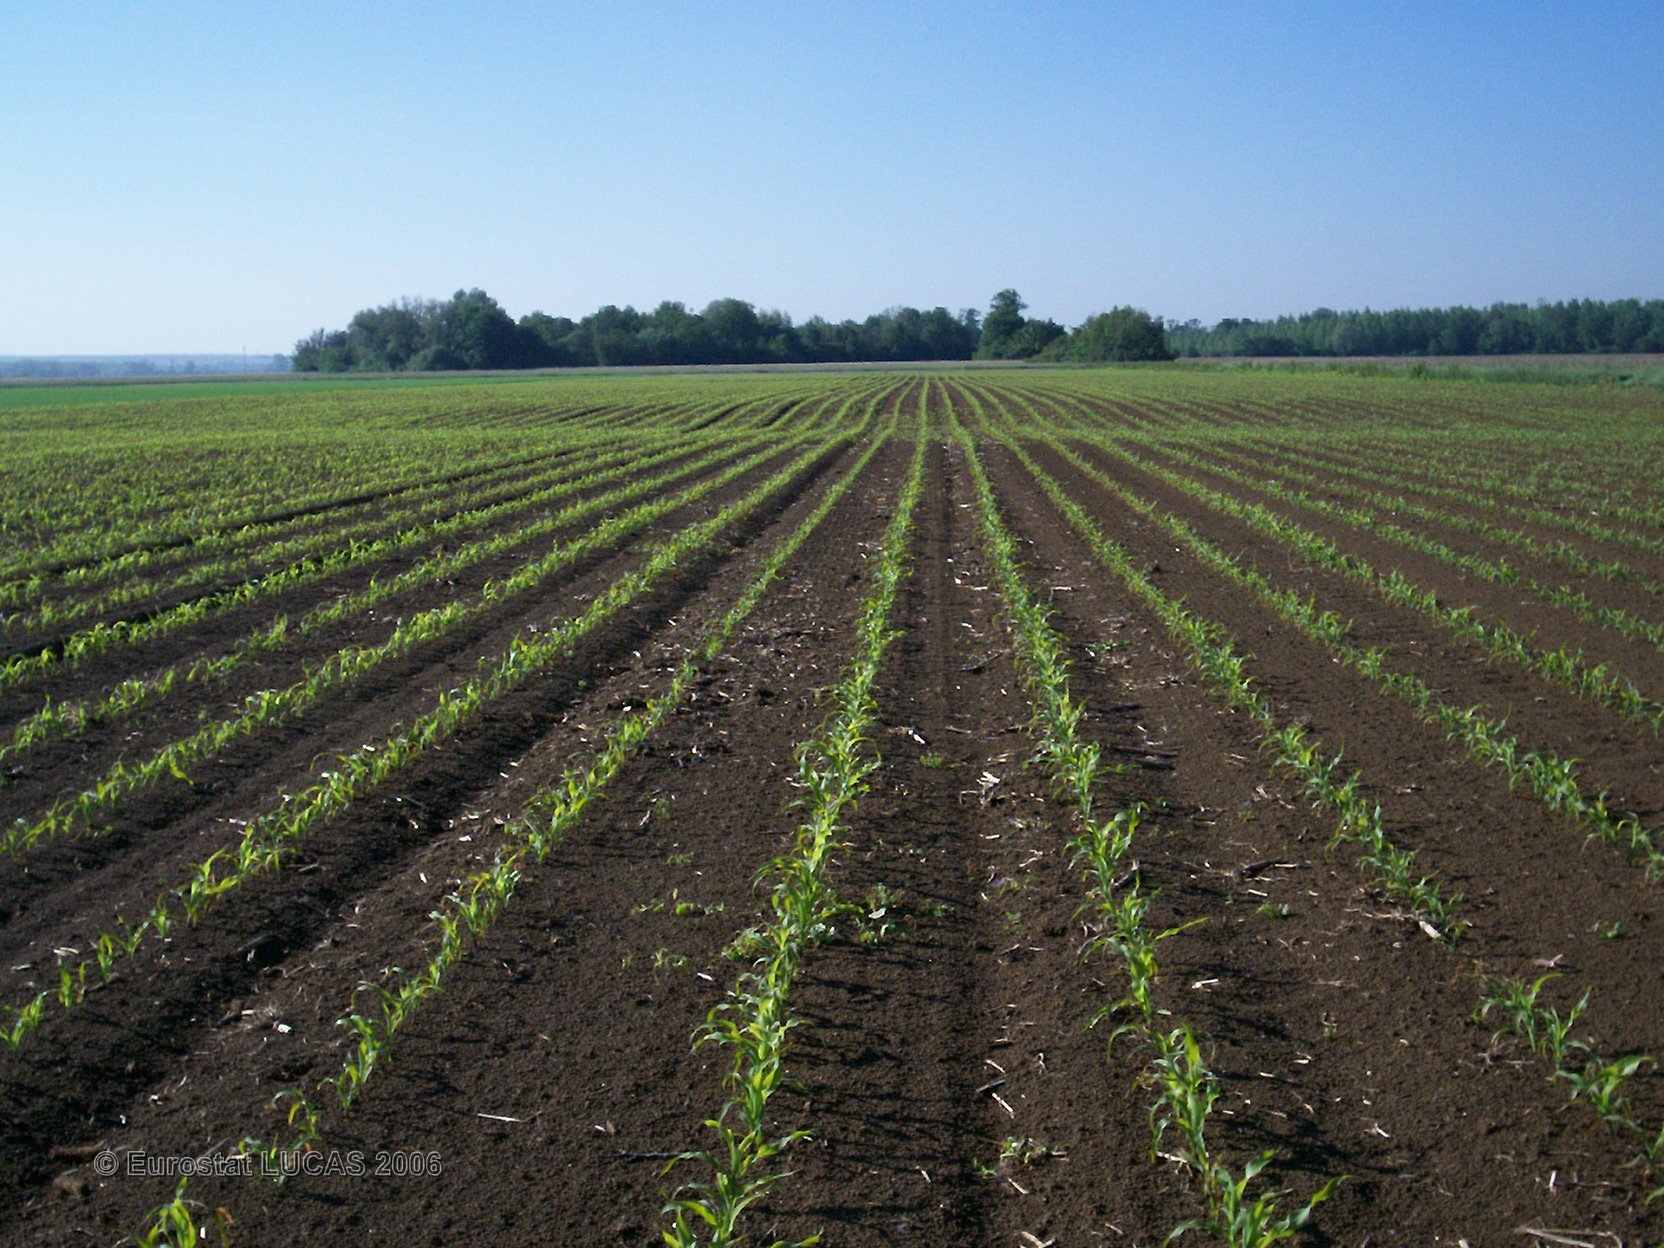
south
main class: Cropland
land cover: Maize
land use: Agriculture (excluding fallow land and kitchen gardens)
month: June
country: FR
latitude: 48.8426
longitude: 4.4783
